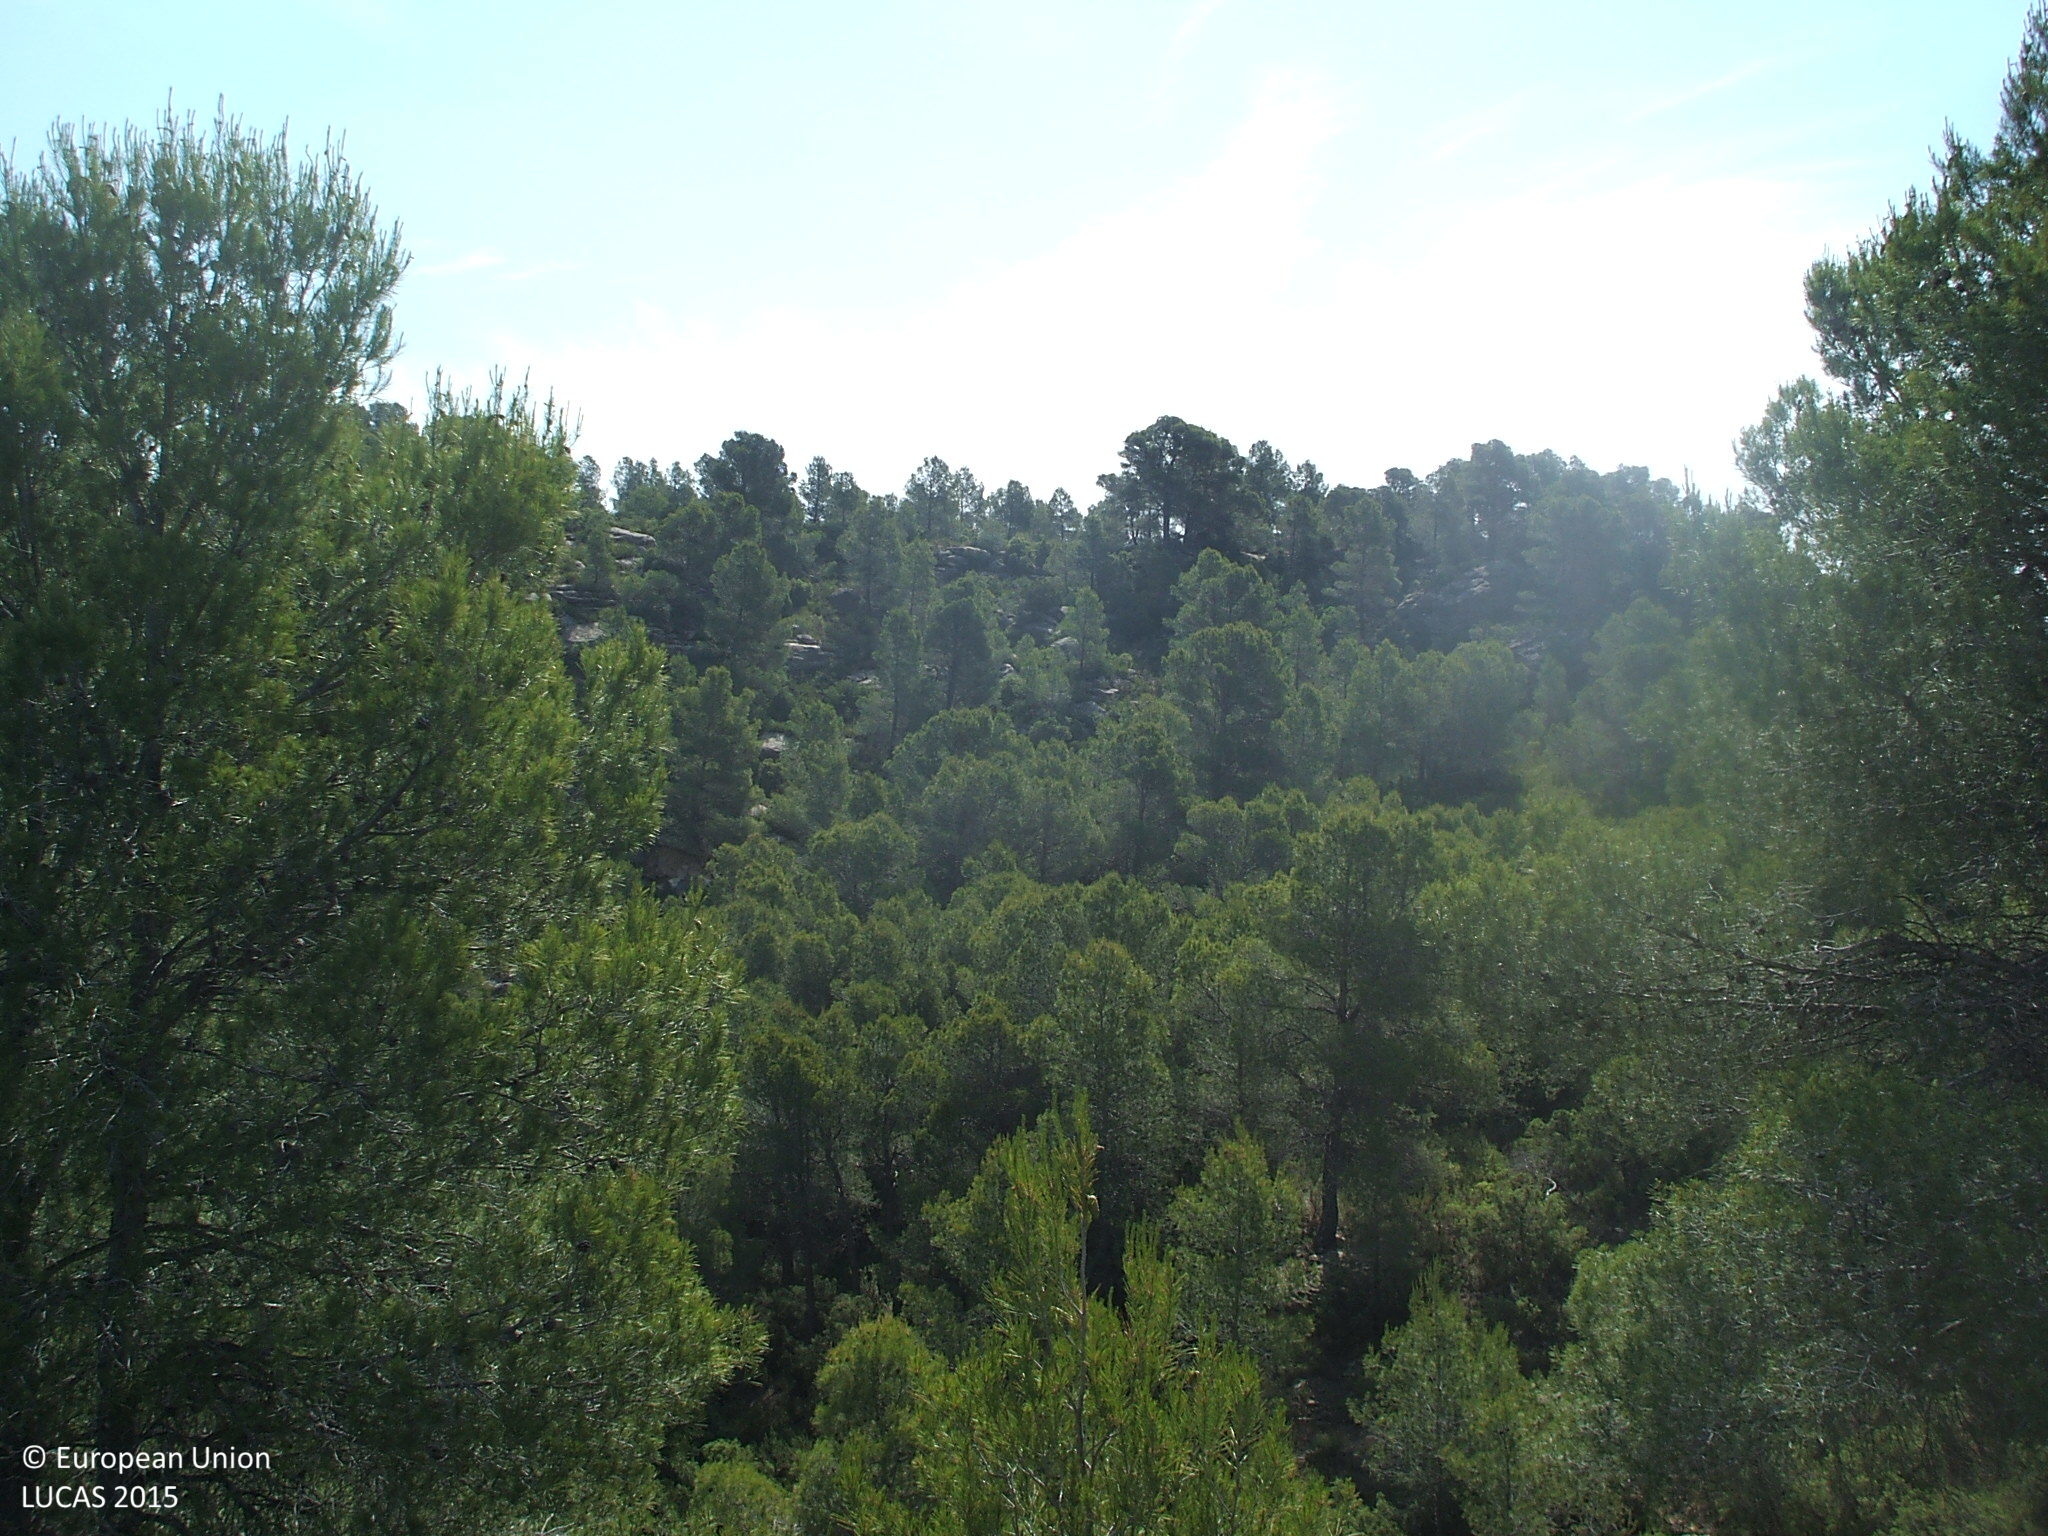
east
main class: Woodland
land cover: Pine dominated coniferous woodland
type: coniferous forest of the mediterranean region
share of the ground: > 75 %
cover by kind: coniferous forest trees 100 %
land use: Semi-natural and natural areas not in use
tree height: > 5 m
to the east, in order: Pine dominated coniferous woodland; Tracks; Pine dominated coniferous woodland
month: June
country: ES
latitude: 41.0343
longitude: 0.2251
